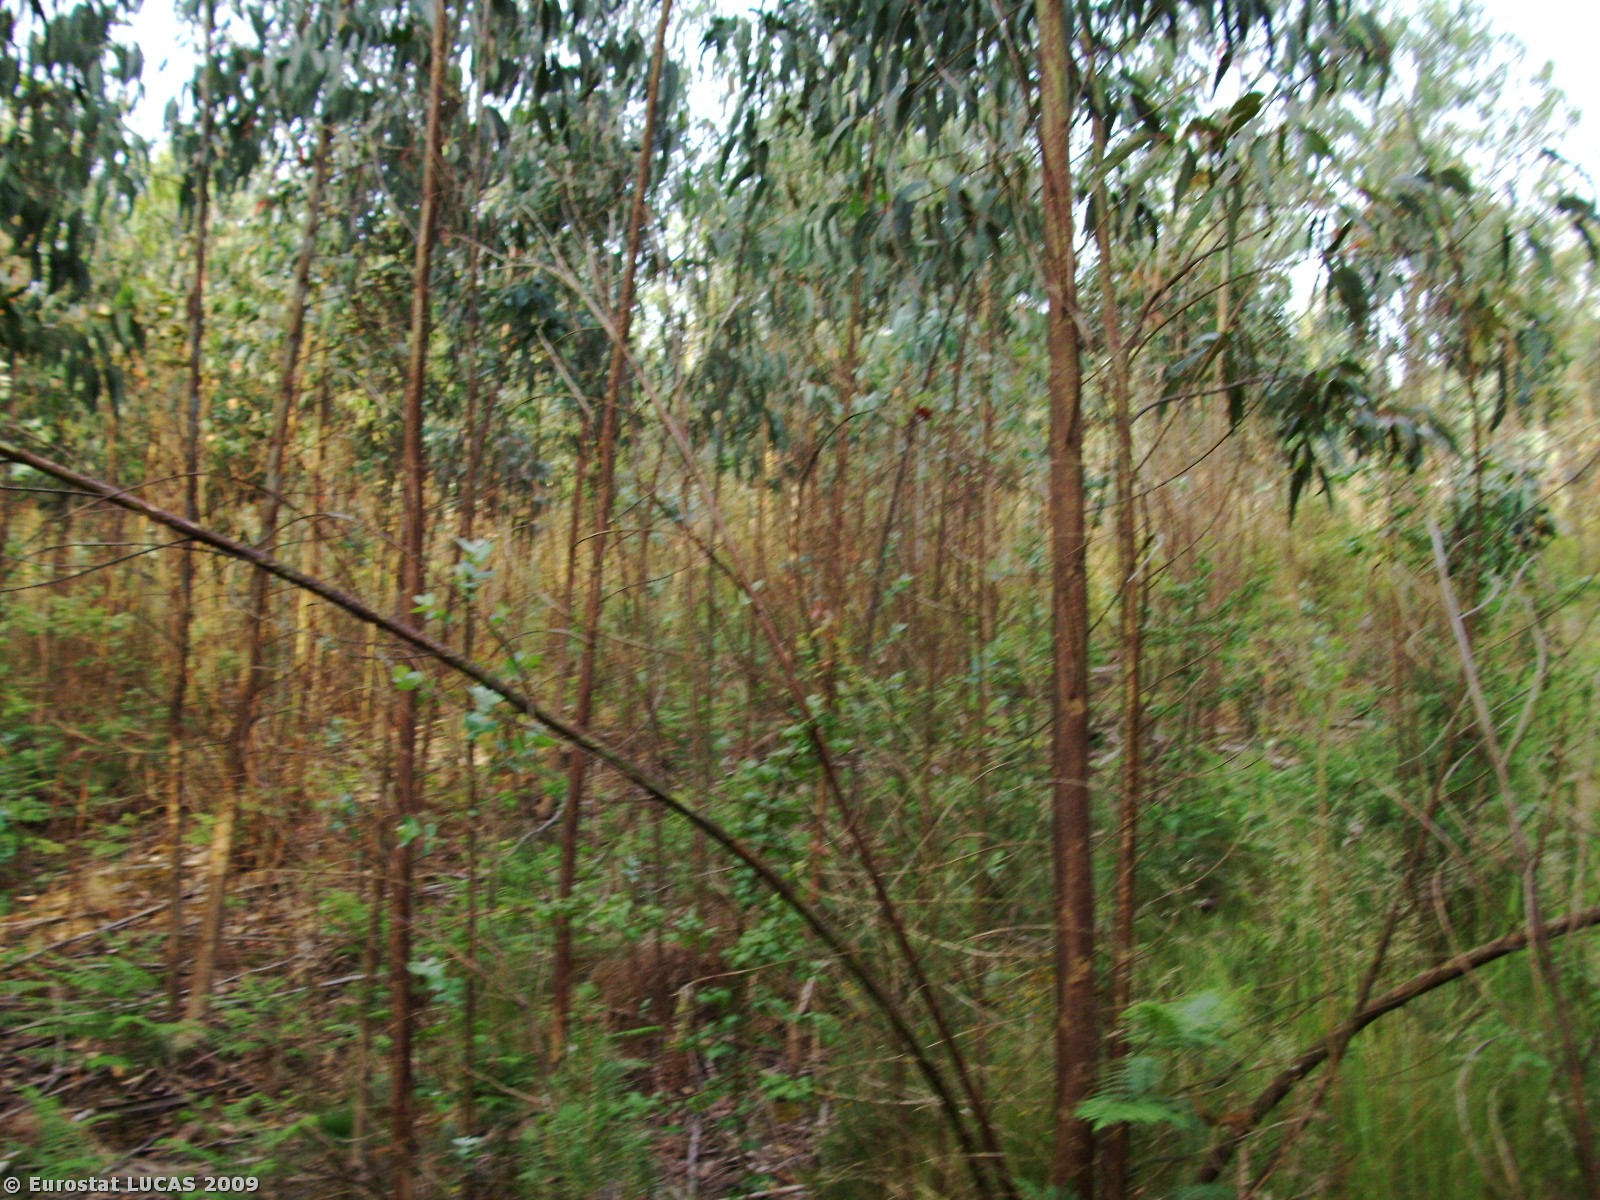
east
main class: Woodland
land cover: Broadleaved woodland
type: plantations and self-sown exotic forest
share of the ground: > 75 %
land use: Forestry
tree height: > 5 m
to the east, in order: Broadleaved woodland; Tracks; Broadleaved woodland; Tracks; Broadleaved woodland
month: May
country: PT
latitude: 41.0554
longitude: -8.5318
